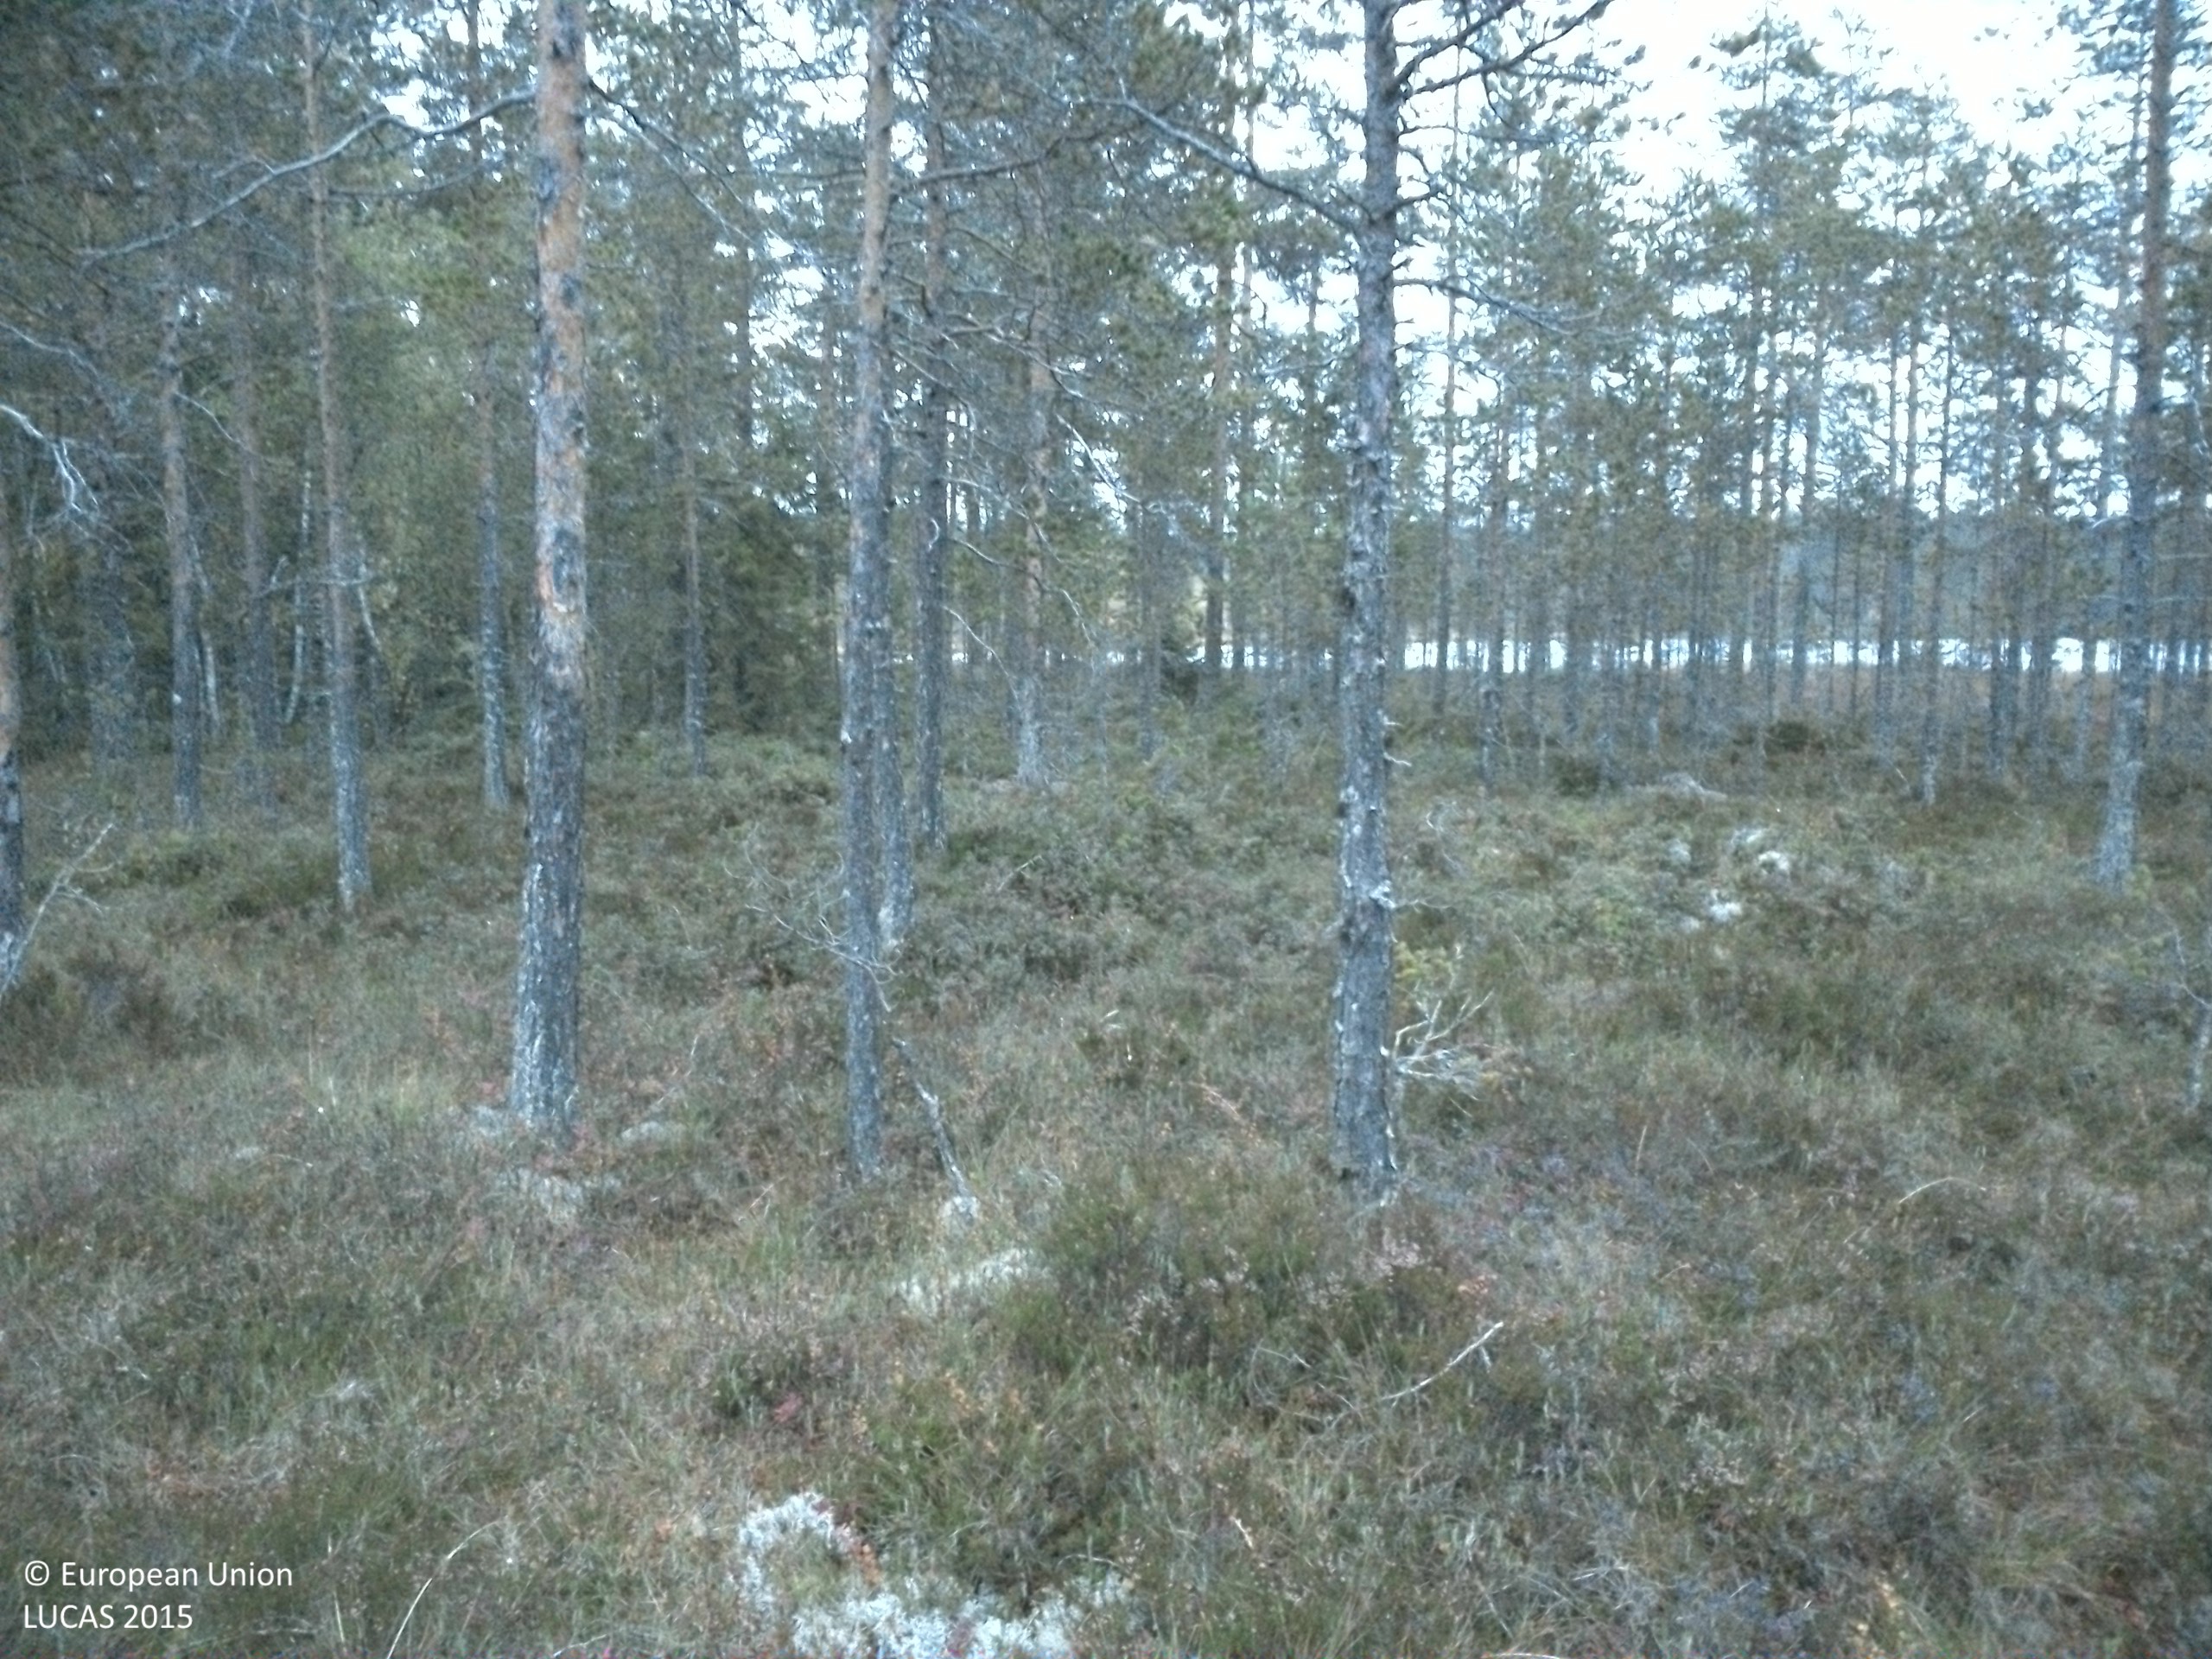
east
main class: Woodland
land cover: Pine dominated coniferous woodland
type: boreal forest
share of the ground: 10 - 25 %
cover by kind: shrubs 40 %, lichens and mosses 40 %, coniferous forest trees 20 %
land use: Forestry
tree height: > 5 m
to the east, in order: Pine dominated coniferous woodland; Peatbogs; Inland fresh water bodies; Peatbogs; Rivers and streams; Broadleaved woodland
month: September
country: SE
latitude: 61.6293
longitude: 14.9078
